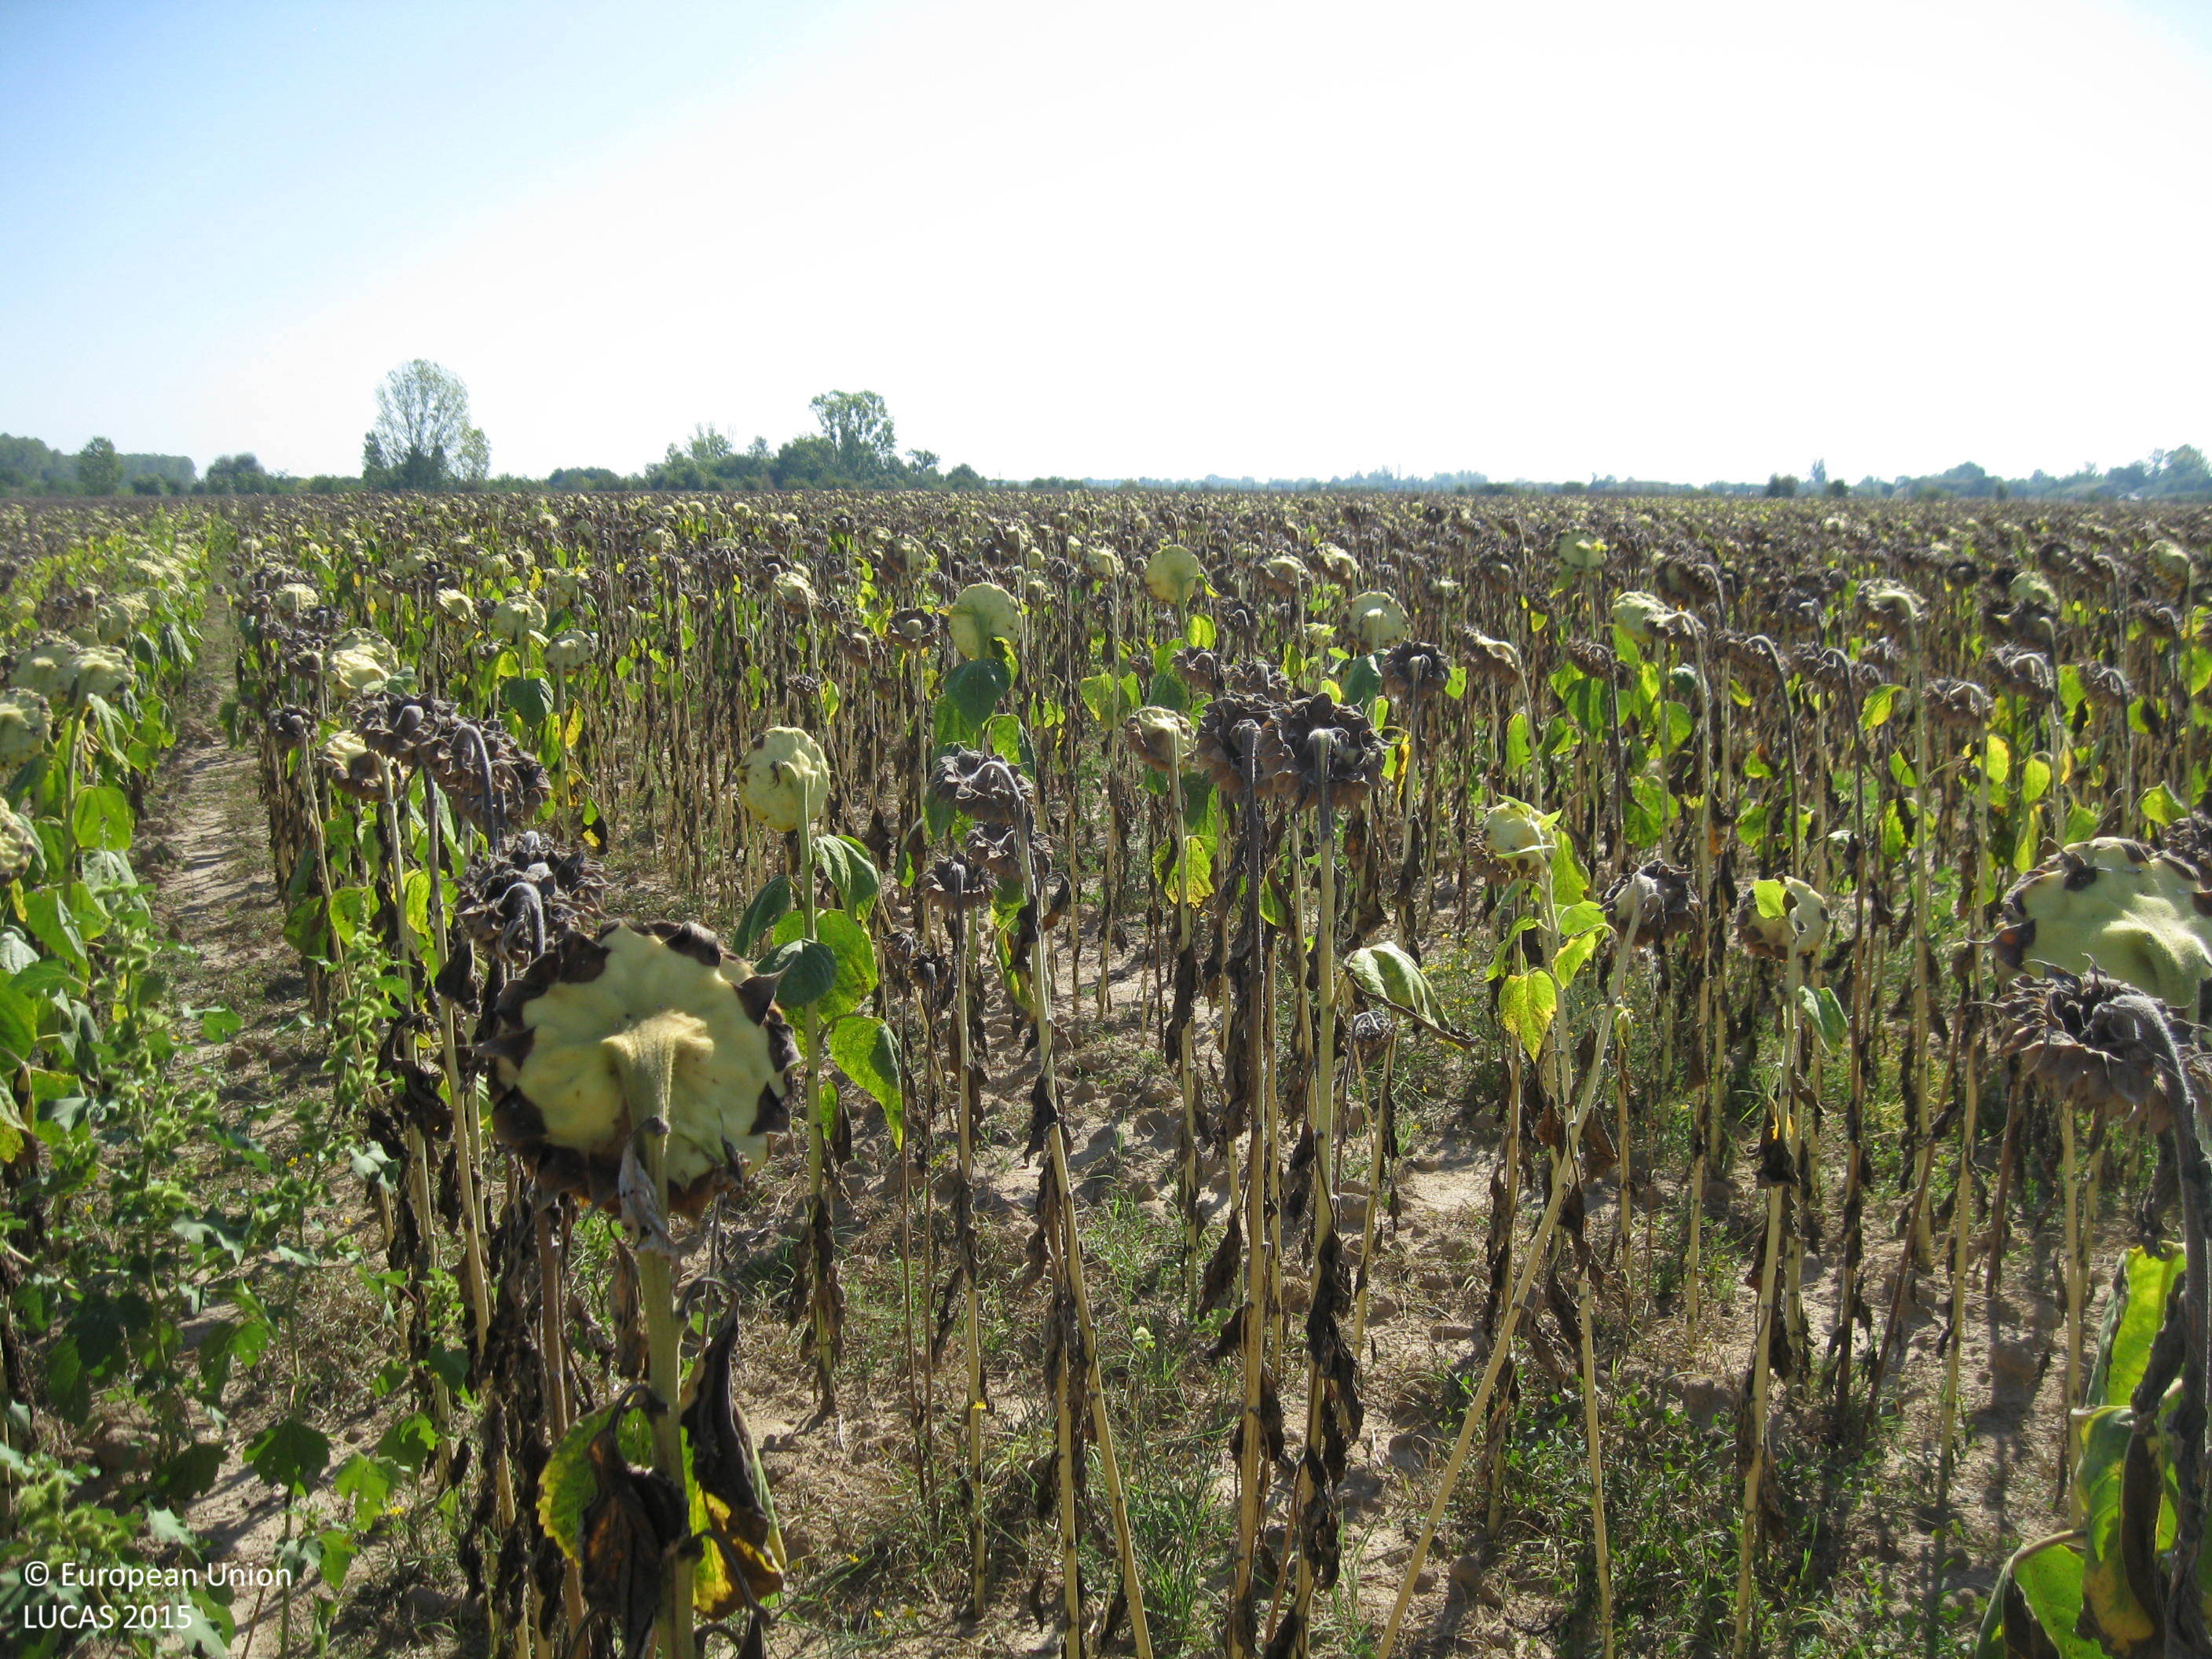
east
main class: Cropland
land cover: Sunflower
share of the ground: > 75 %
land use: Agriculture (excluding fallow land and kitchen gardens)
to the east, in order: Sunflower
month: September
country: BG
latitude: 42.2908
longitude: 24.6908
